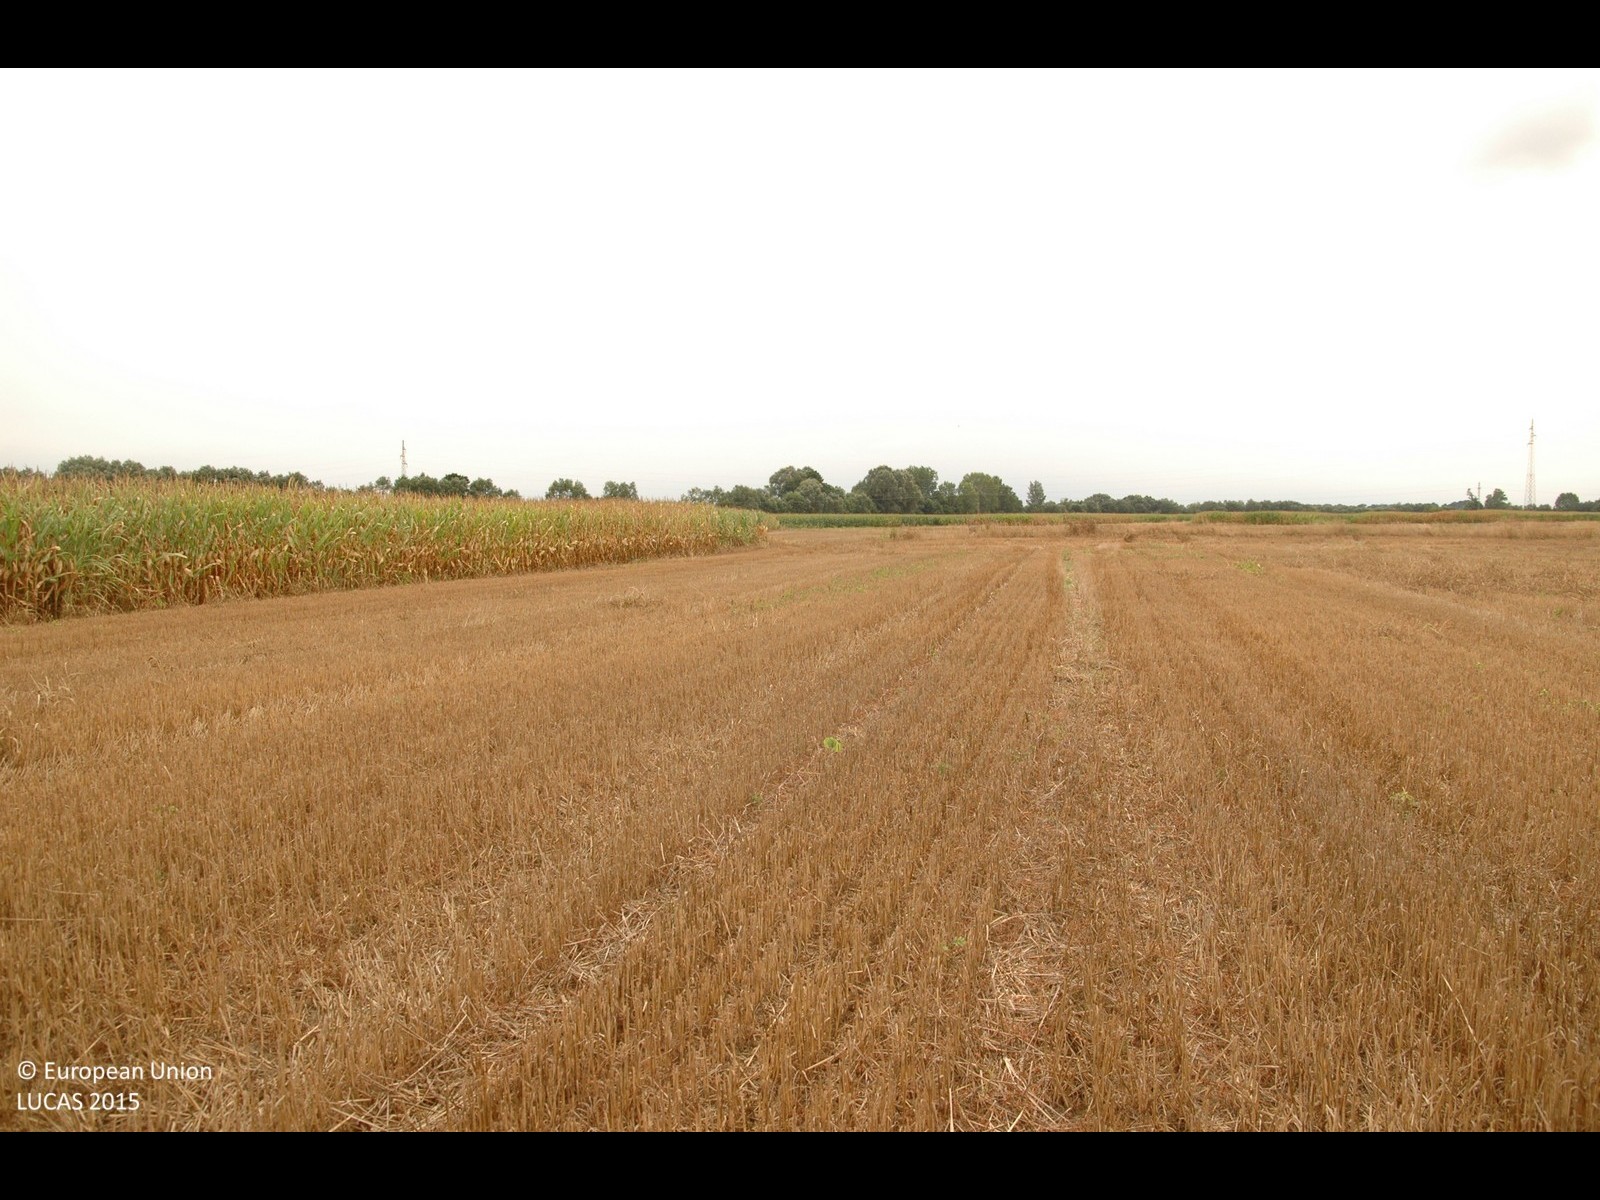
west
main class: Cropland
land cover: Common wheat
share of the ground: > 75 %
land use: Agriculture (excluding fallow land and kitchen gardens)
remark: Harvested field
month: August
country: HR
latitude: 46.2375
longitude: 16.8877
